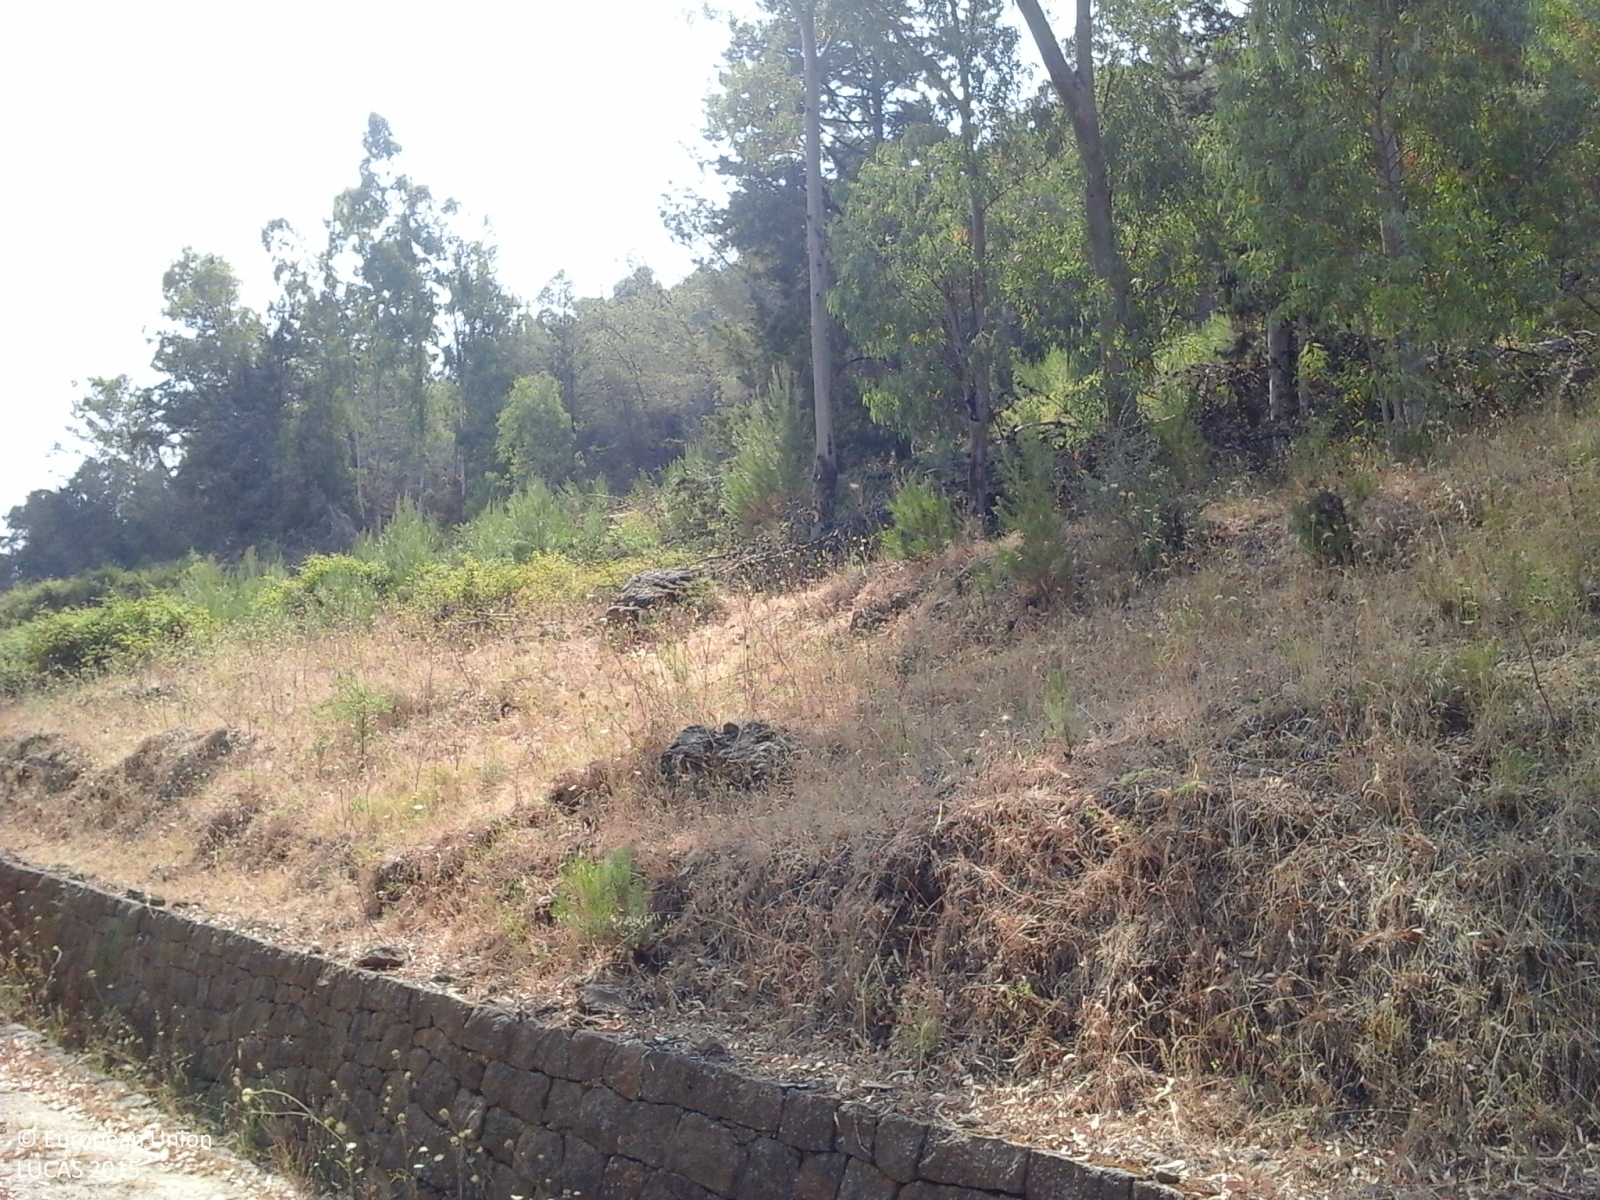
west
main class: Woodland
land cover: Other mixed woodland
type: broadleaved evergreen forest
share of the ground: > 75 %
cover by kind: herbaceous plants 50 %, coniferous forest trees 20 %, broadleaved forest trees 20 %, shrubs 10 %
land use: Forestry
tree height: > 5 m
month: July
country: IT
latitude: 37.2082
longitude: 14.7975
